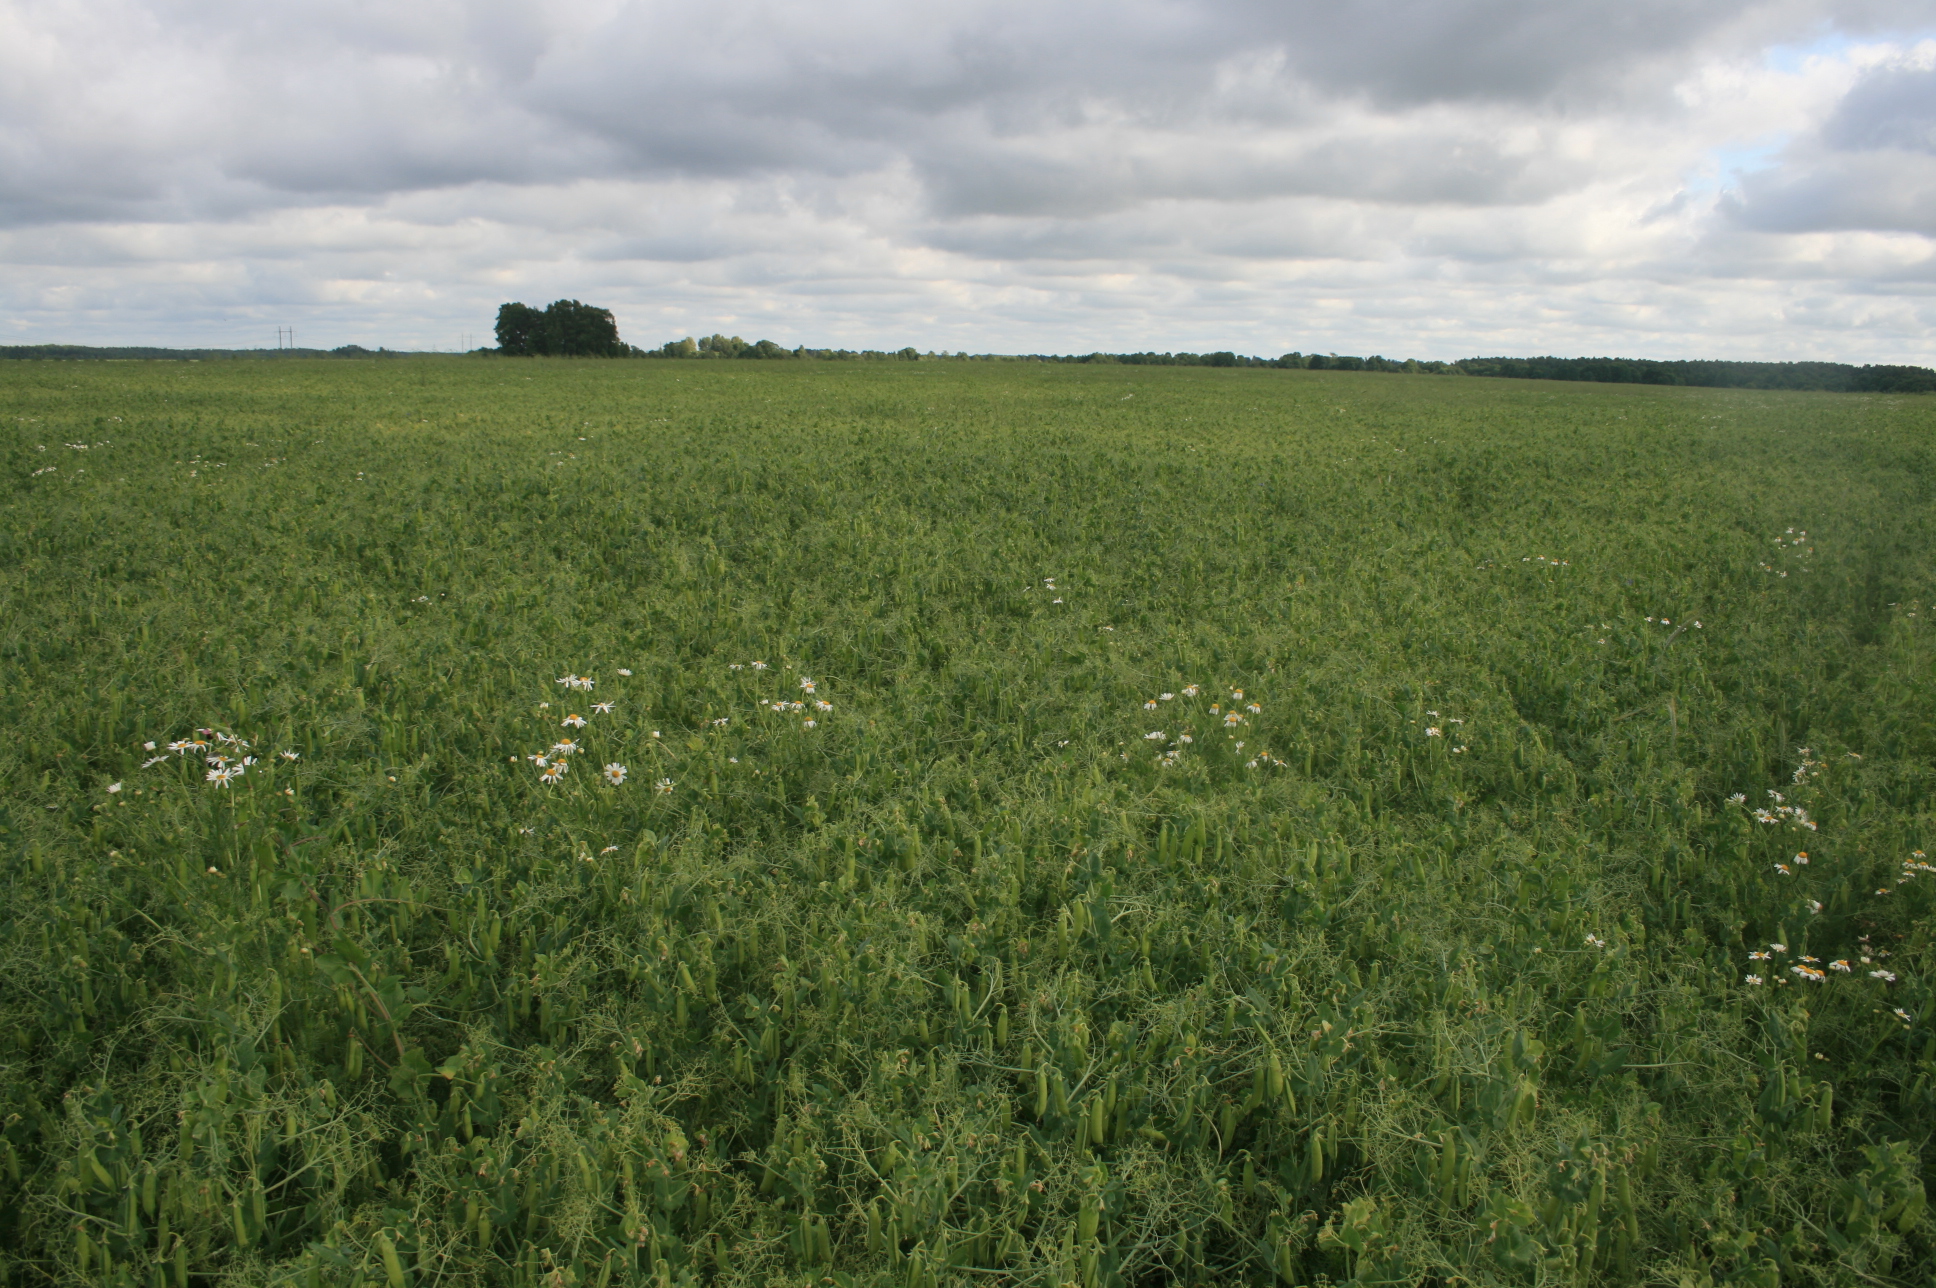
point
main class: Cropland
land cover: Dry pulses
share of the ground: > 75 %
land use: Agriculture (excluding fallow land and kitchen gardens)
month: July
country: LT
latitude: 55.9416
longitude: 21.2970
